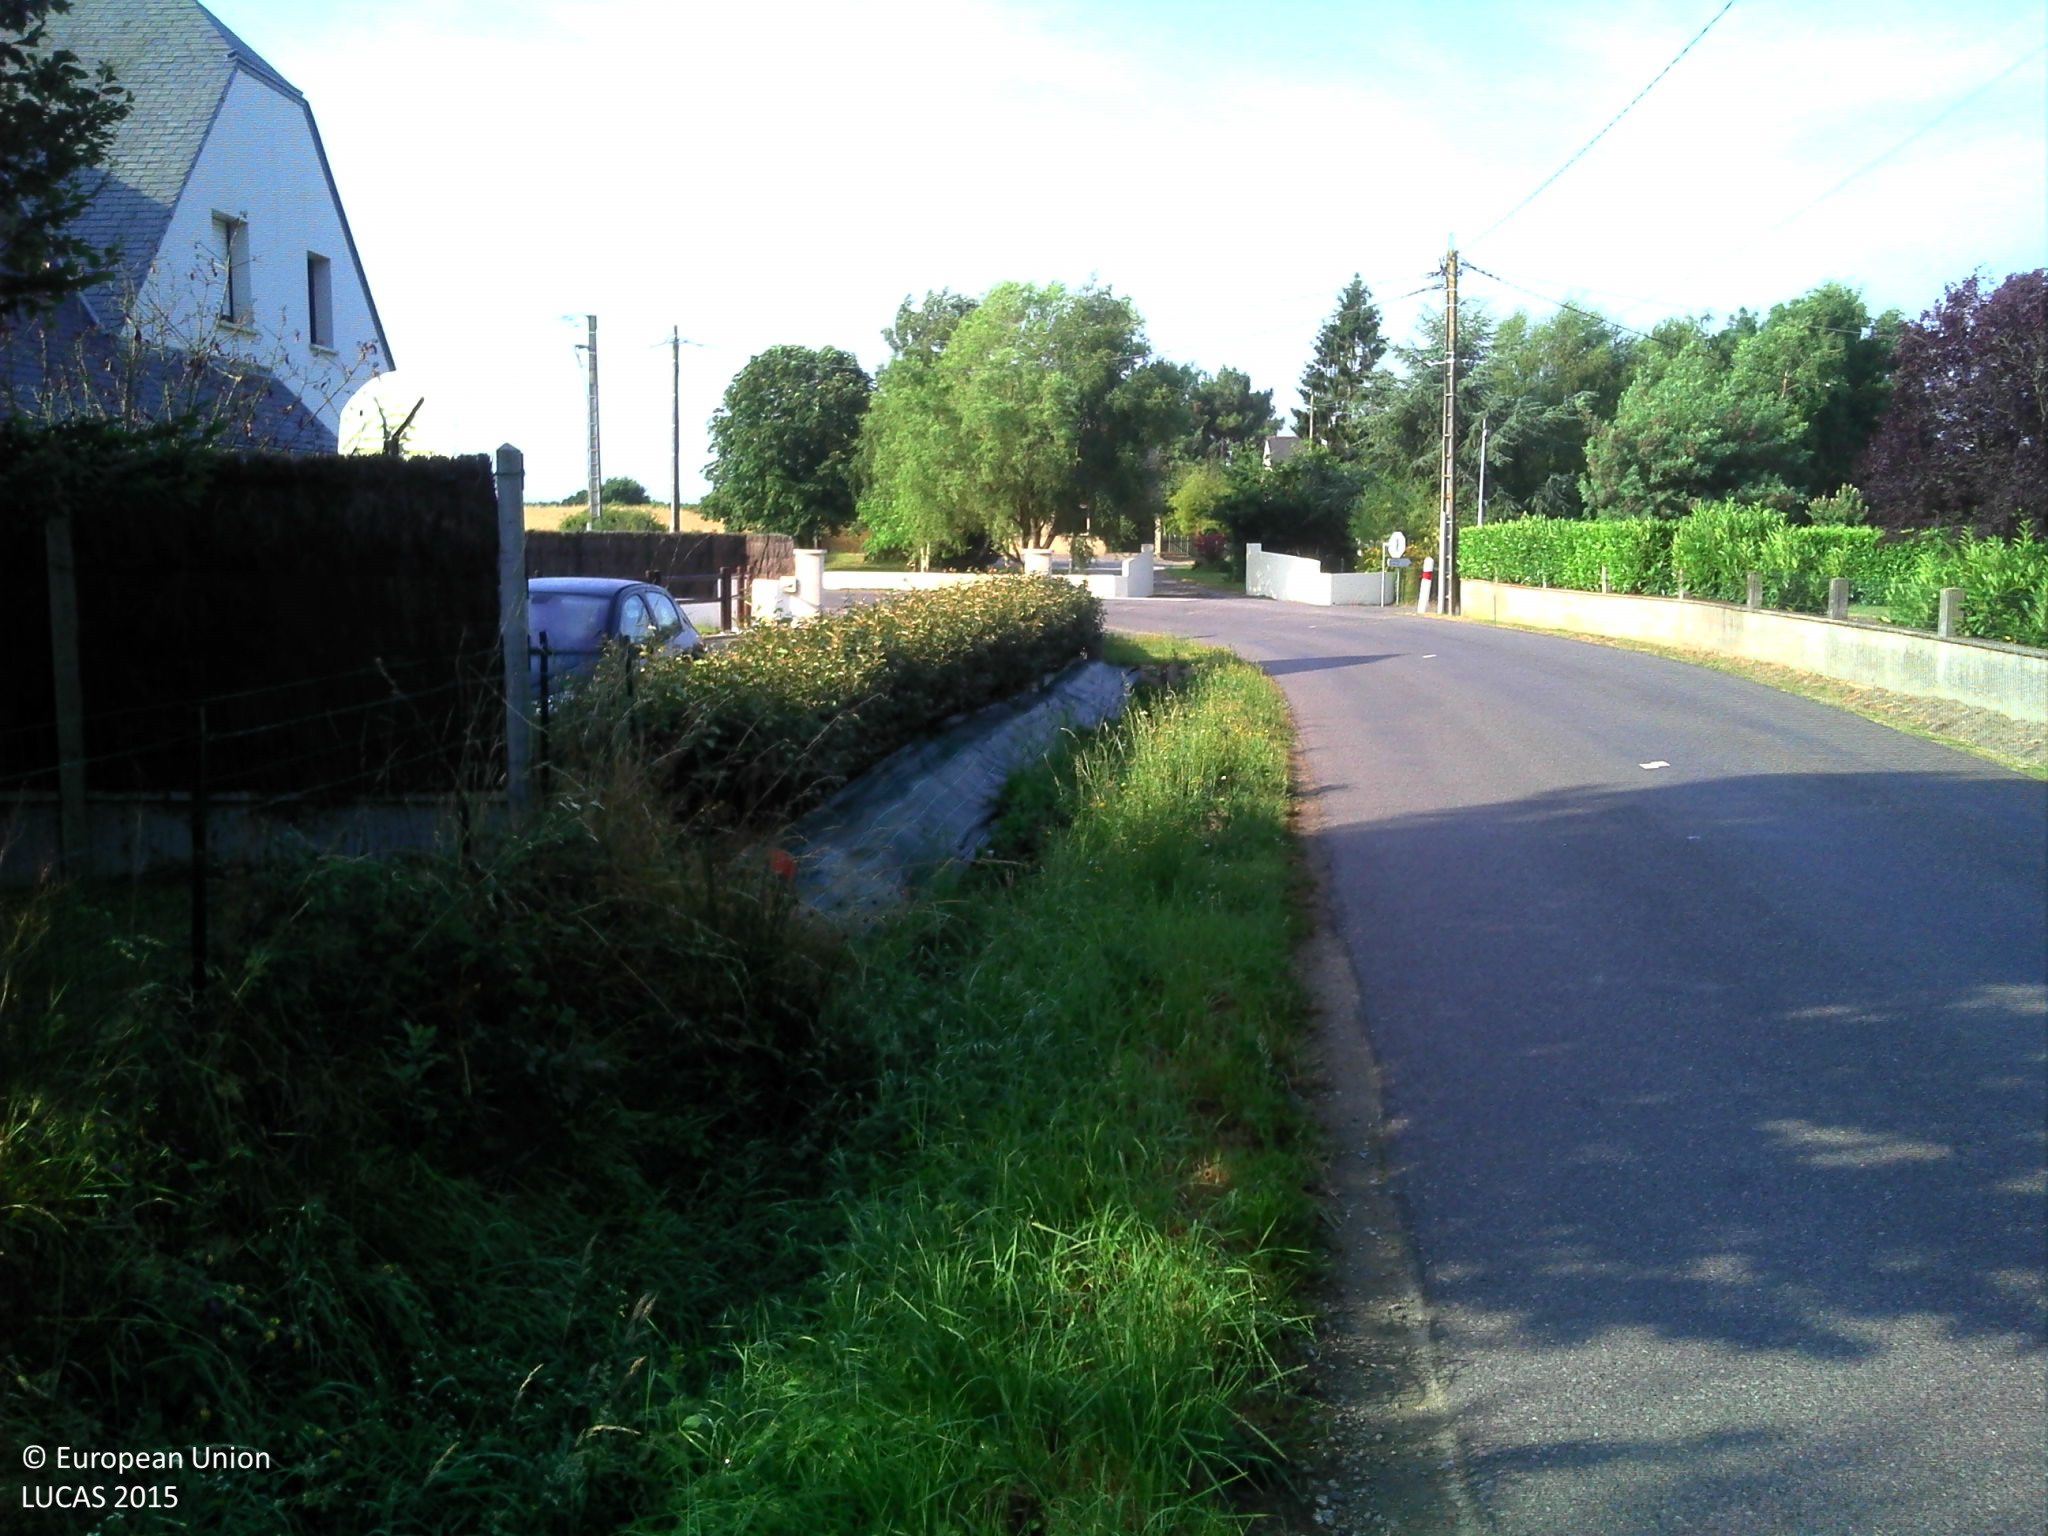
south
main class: Grassland
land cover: Grassland with sparse tree/shrub cover
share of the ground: > 75 %
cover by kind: herbaceous plants 95 %, broadleaved forest trees 5 %
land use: Residential
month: July
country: FR
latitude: 47.3378
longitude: -1.9191
